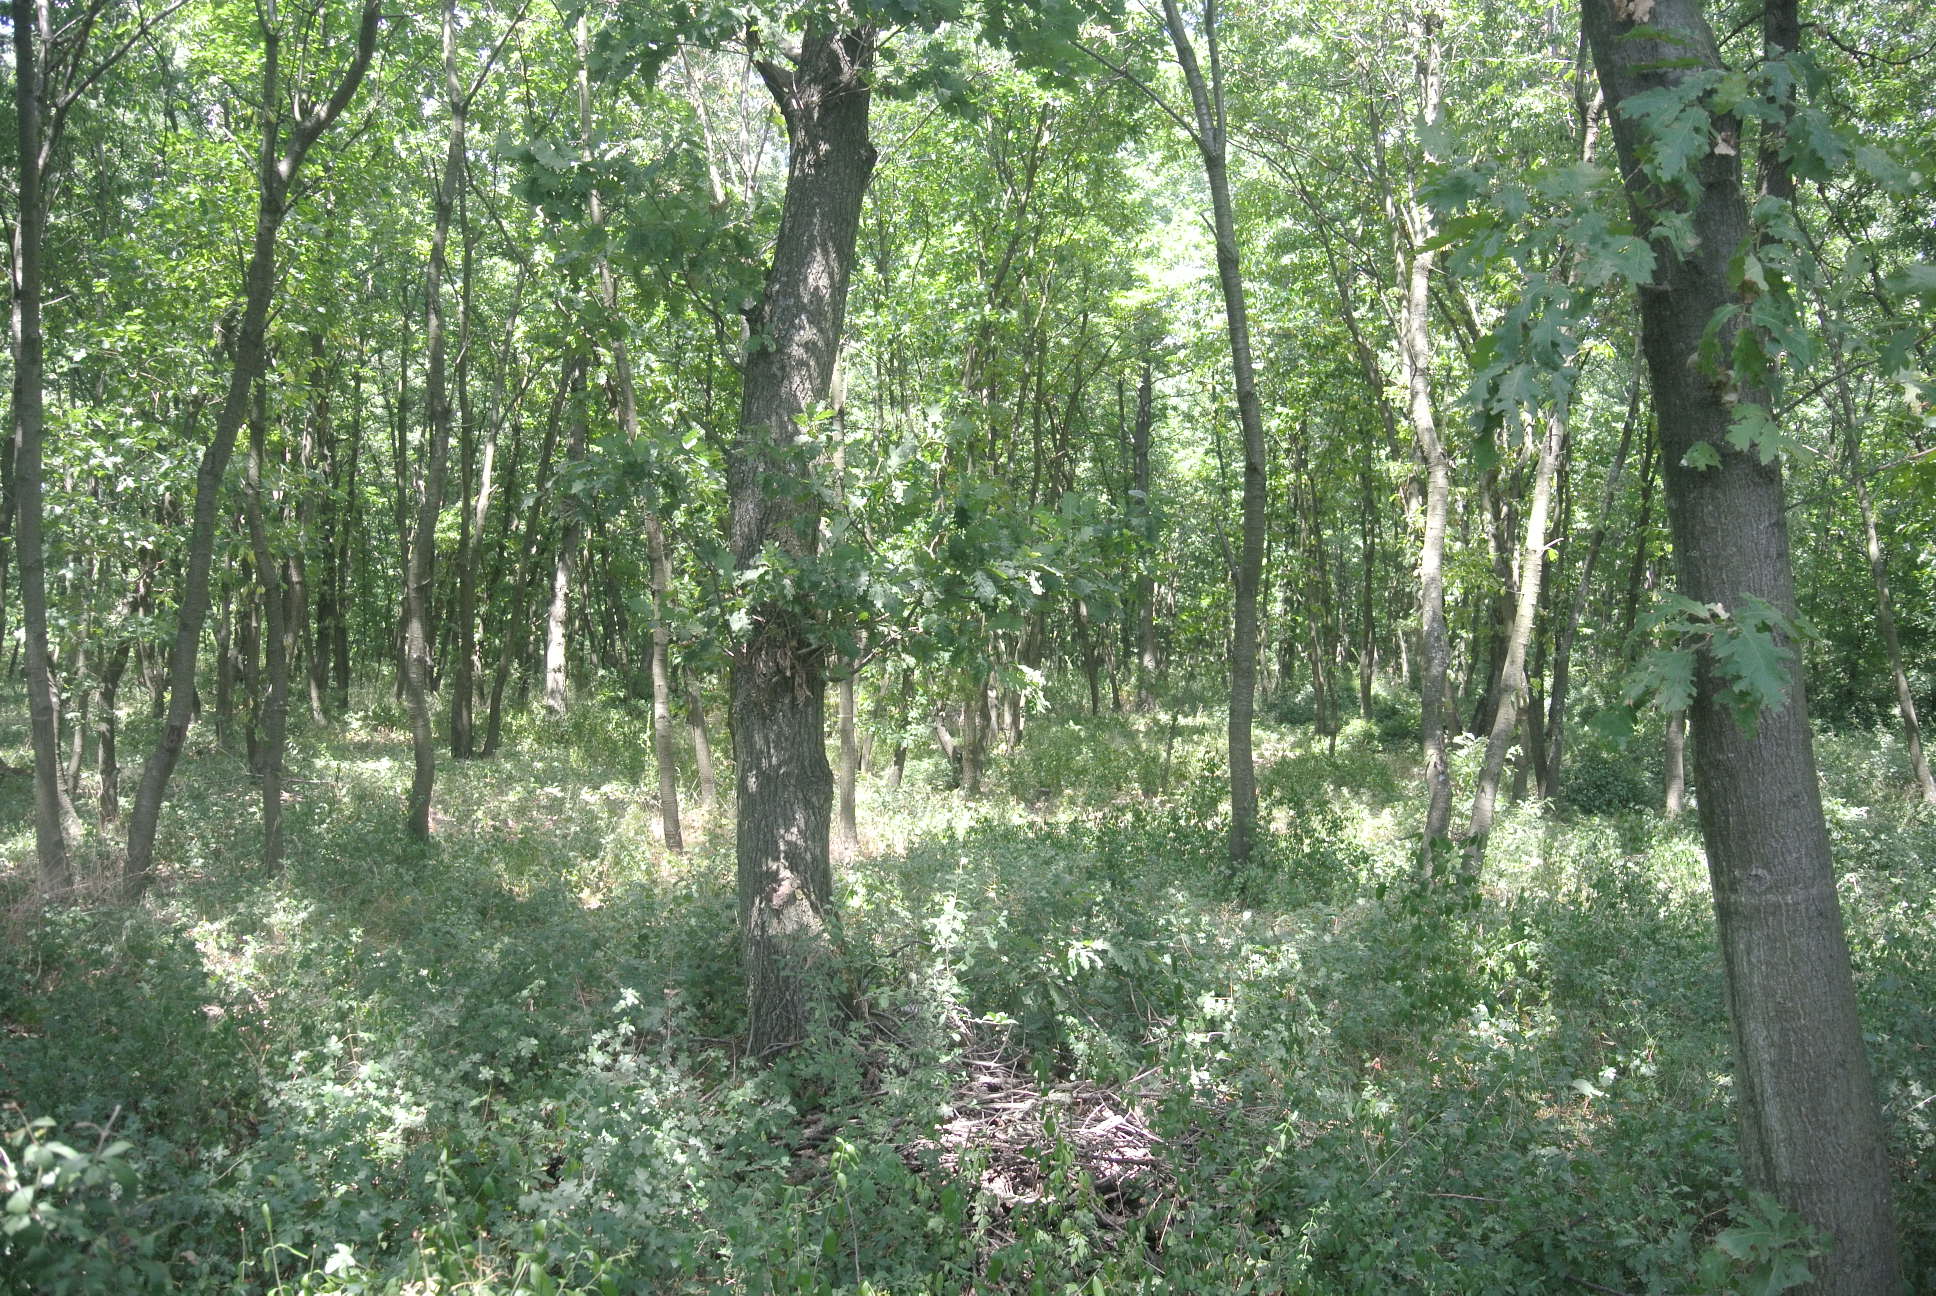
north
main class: Woodland
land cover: Broadleaved woodland
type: beech forest
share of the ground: > 75 %
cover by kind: broadleaved forest trees 100 %
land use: Forestry
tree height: > 5 m
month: July
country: AT
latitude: 47.5736
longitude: 16.6114
